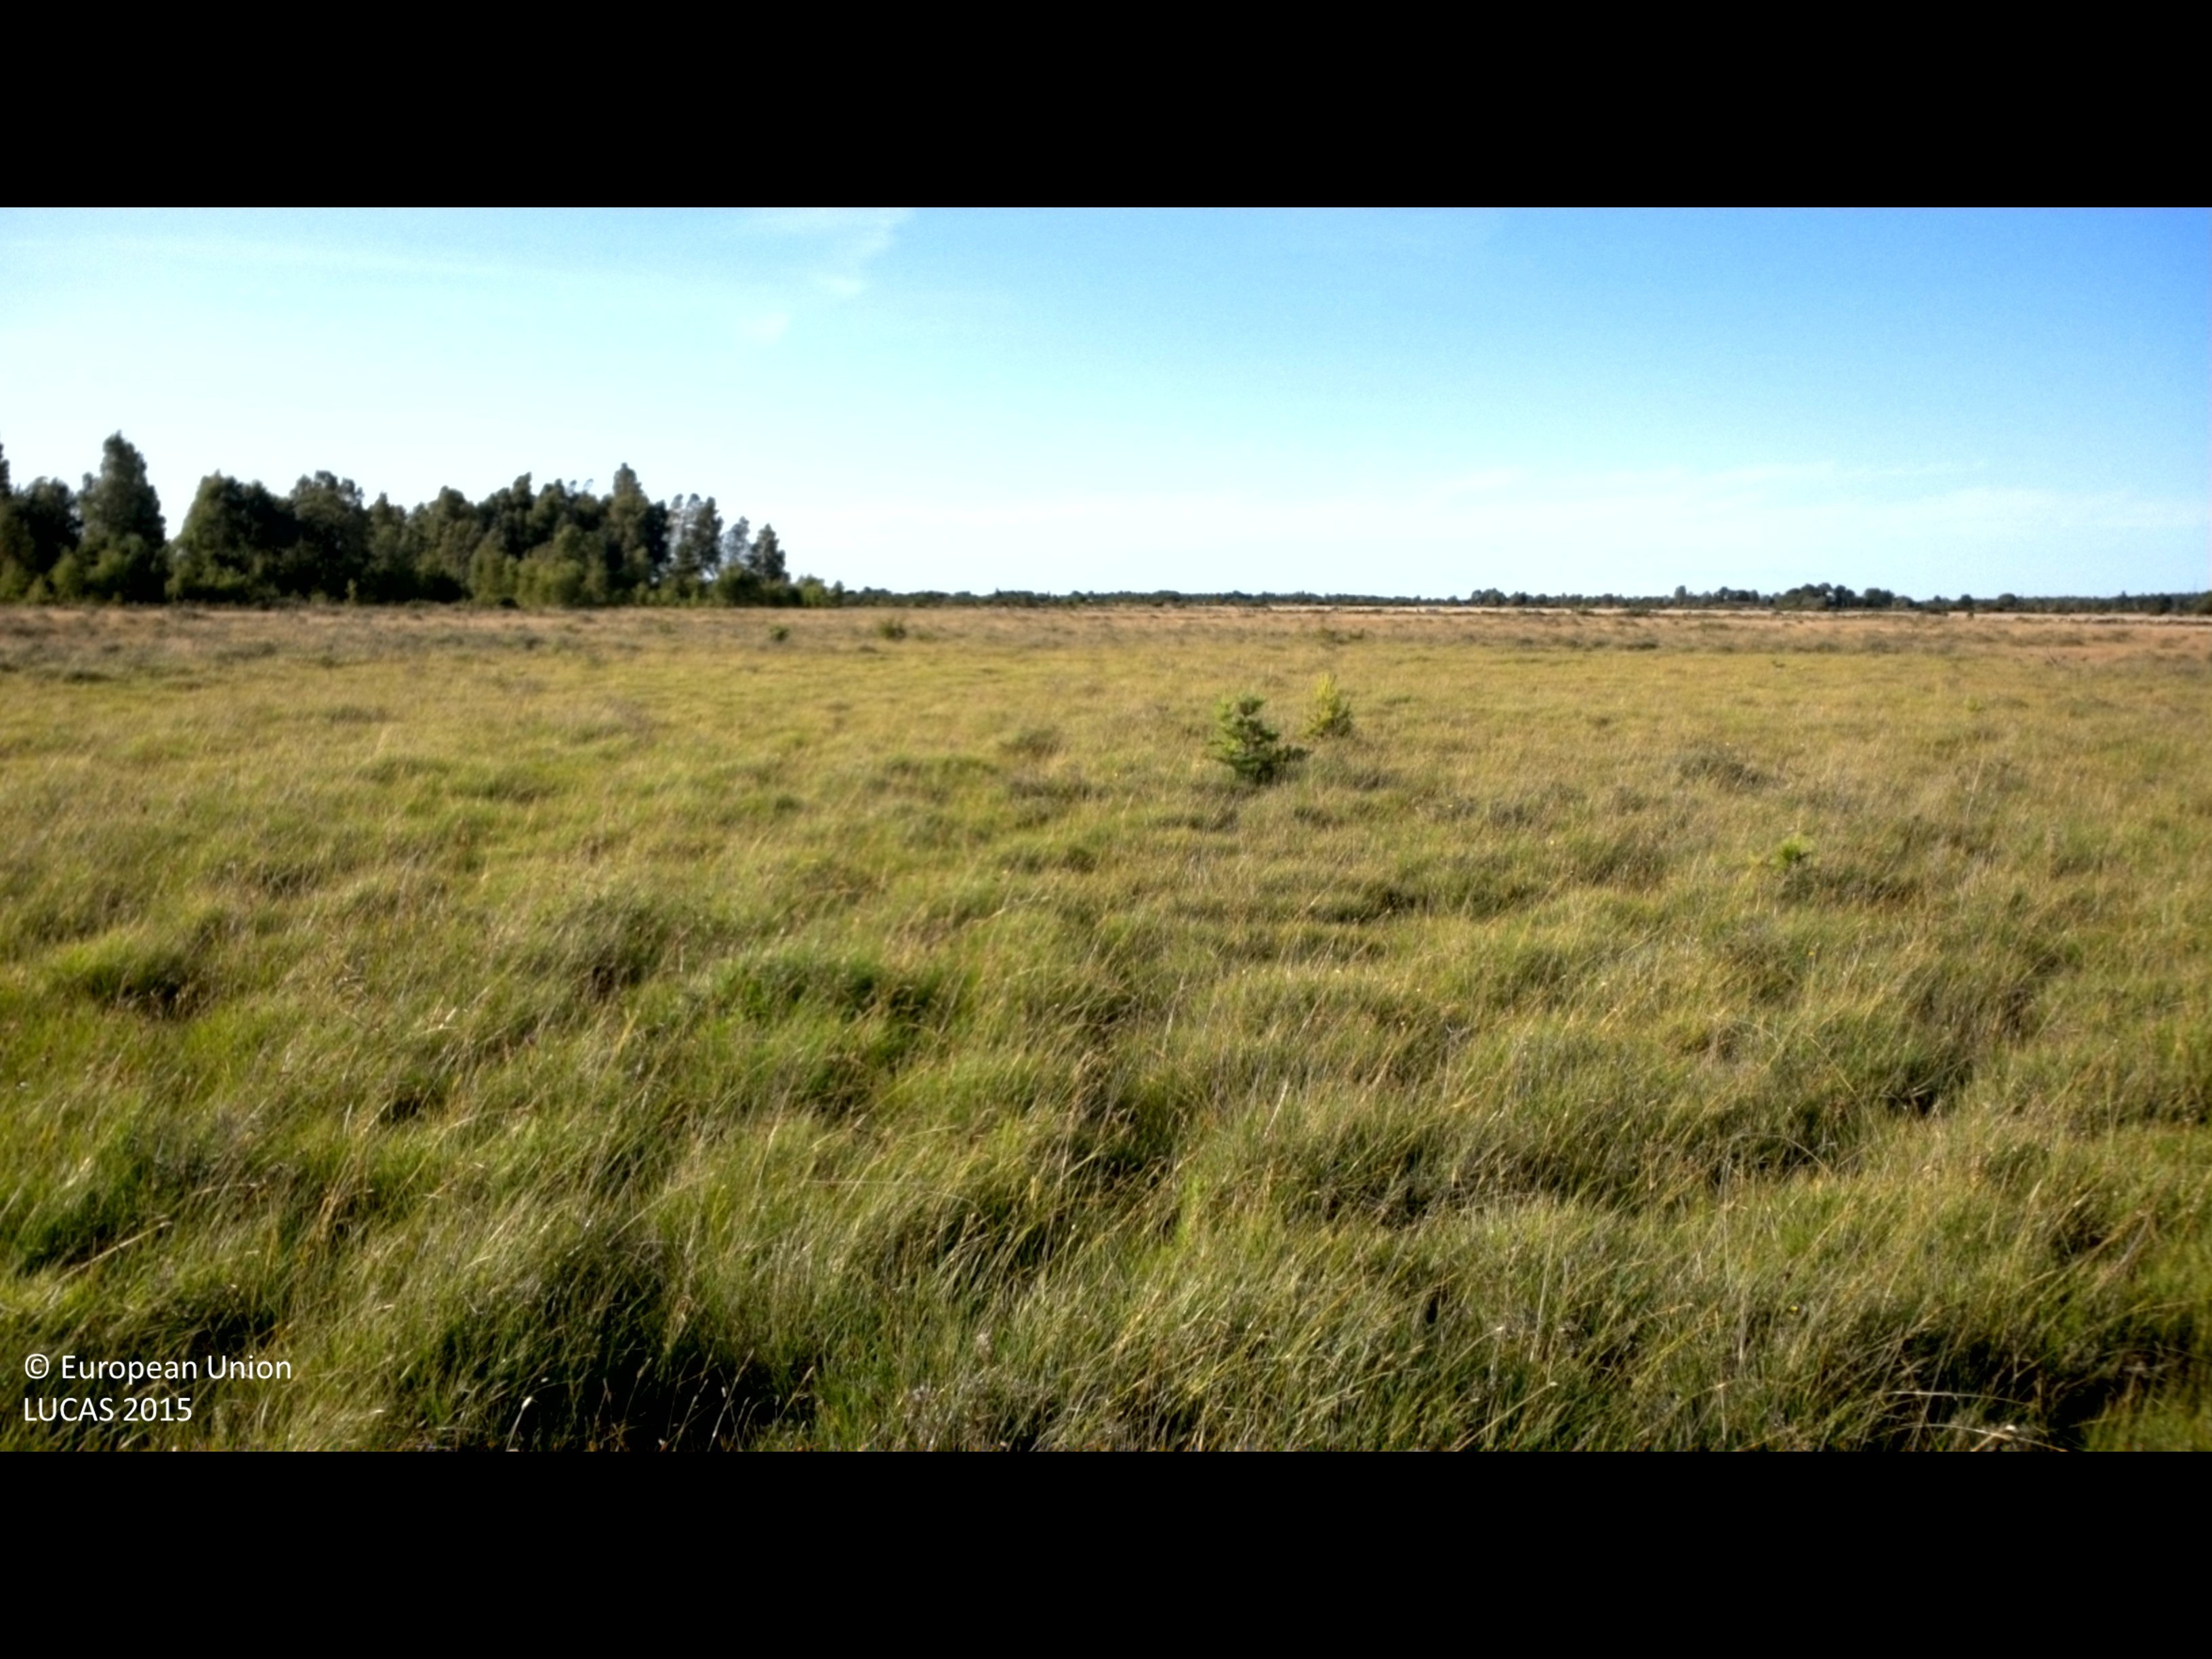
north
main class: Grassland
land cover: Grassland without tree/shrub cover
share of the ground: > 75 %
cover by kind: herbaceous plants 100 %
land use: Agriculture (excluding fallow land and kitchen gardens)
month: July
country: SE
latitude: 56.5239
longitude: 16.5855
